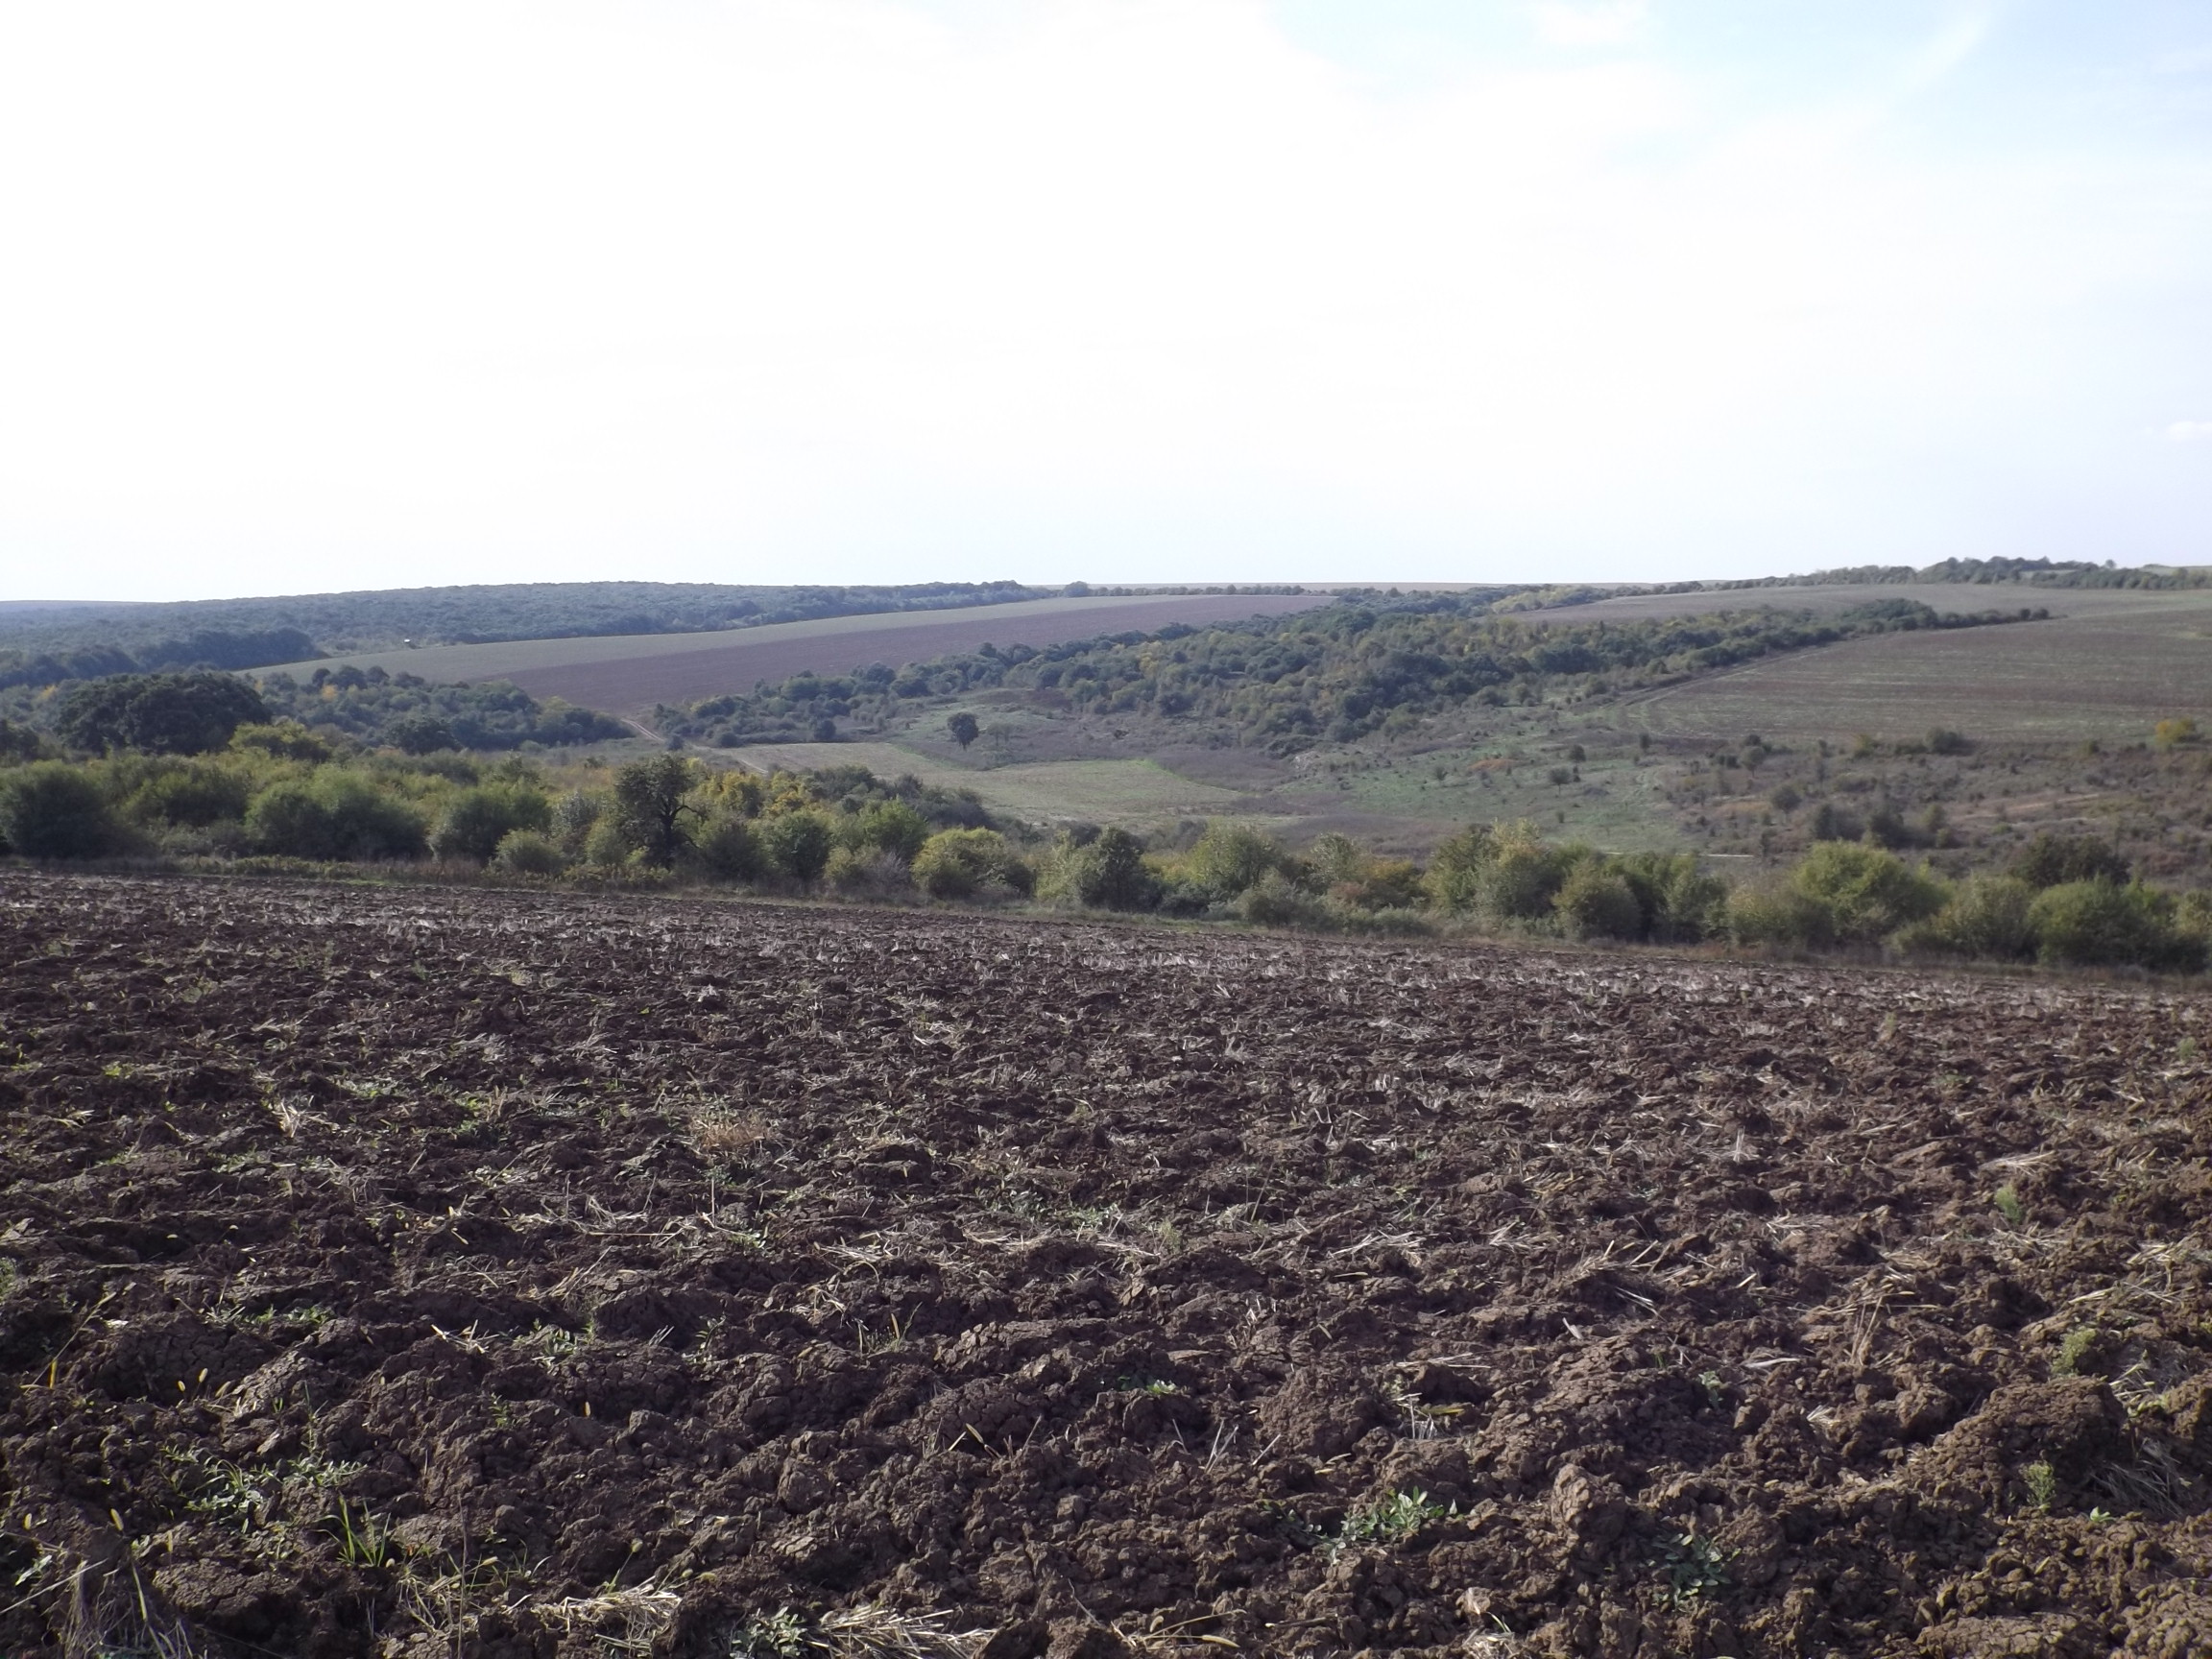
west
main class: Cropland
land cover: Common wheat
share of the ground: < 10 %
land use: Agriculture (excluding fallow land and kitchen gardens)
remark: Harvested field
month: October
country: BG
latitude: 43.8681
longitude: 26.7009
